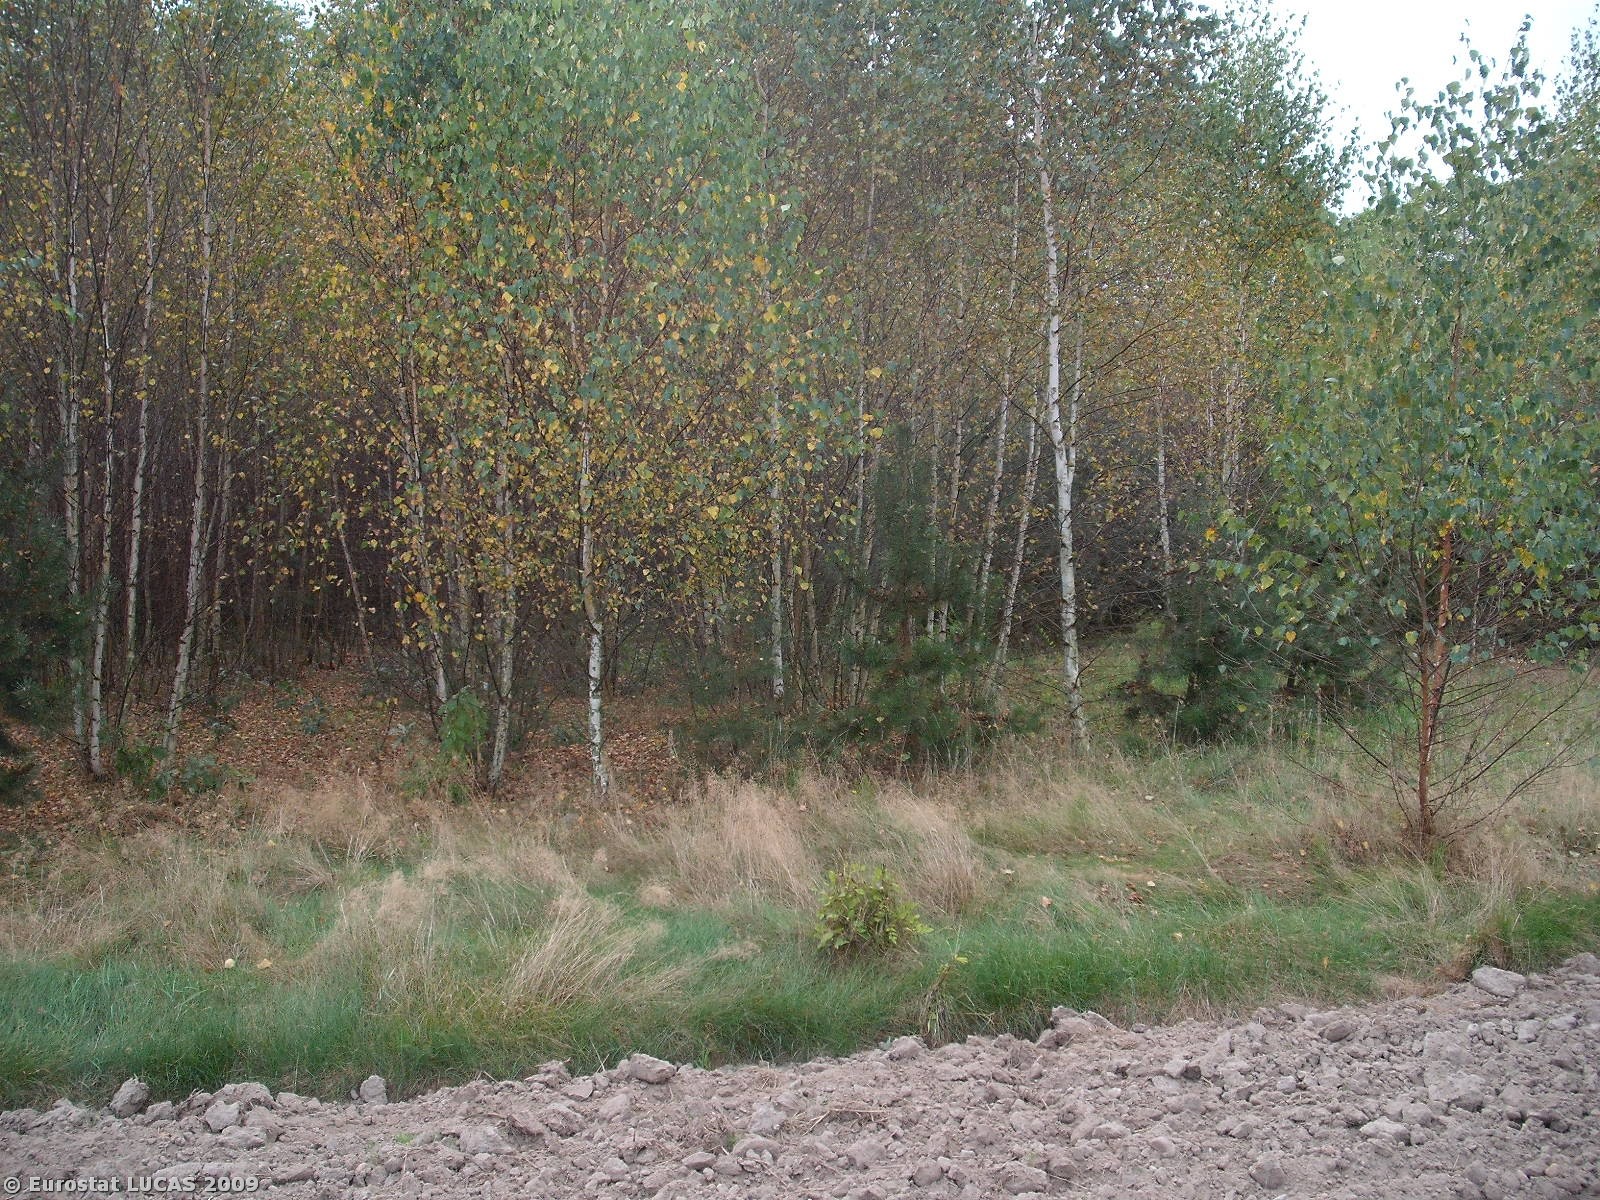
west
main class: Cropland
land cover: Rye
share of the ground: < 10 %
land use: Agriculture (excluding fallow land and kitchen gardens)
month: September
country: PL
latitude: 52.0298
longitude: 20.7839
